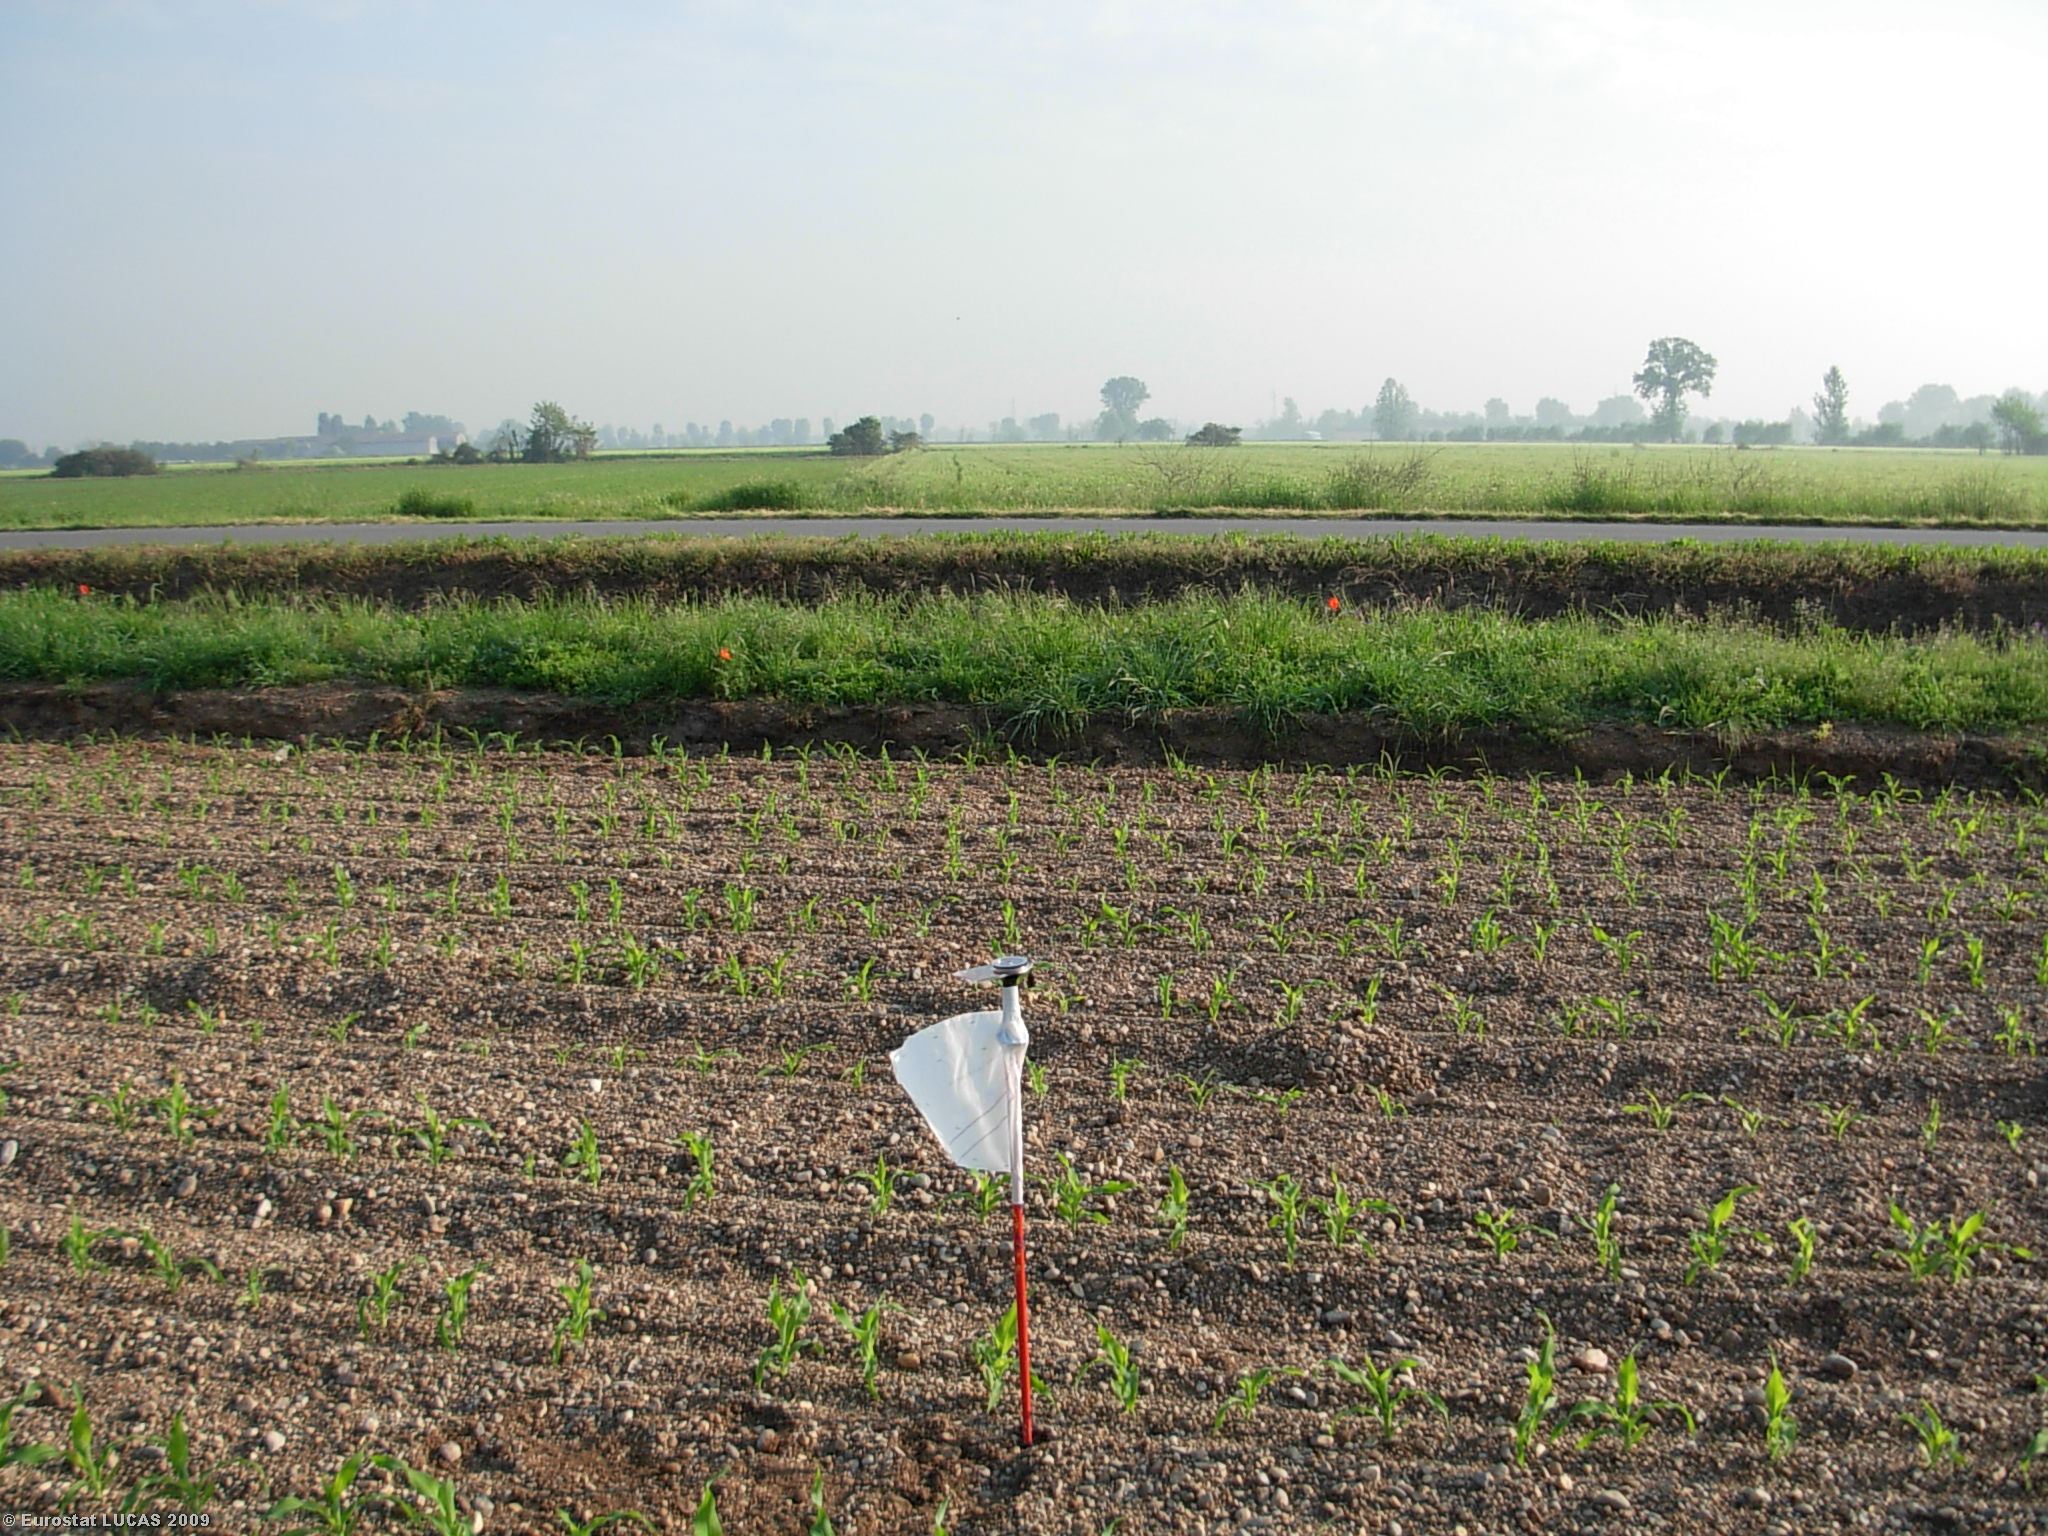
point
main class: Cropland
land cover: Maize
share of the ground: < 10 %
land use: Agriculture (excluding fallow land and kitchen gardens)
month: May
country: IT
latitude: 45.2695
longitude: 10.3435
